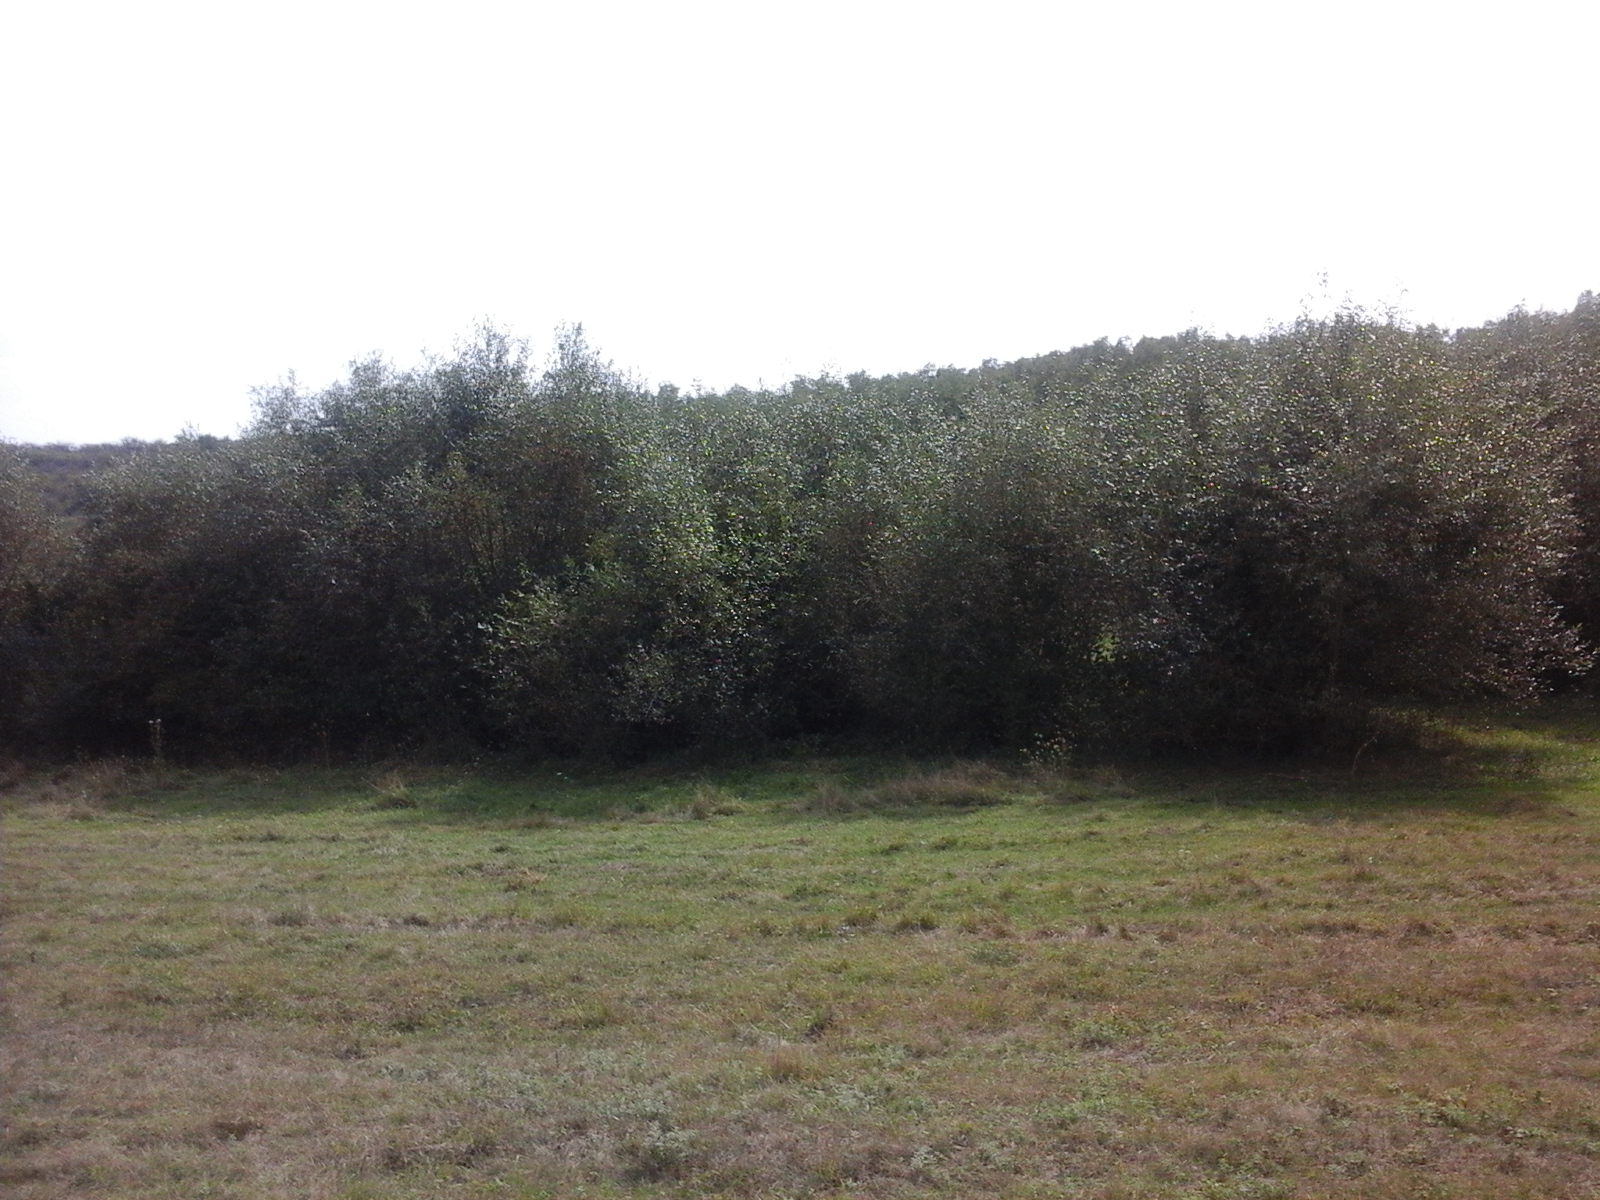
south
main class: Grassland
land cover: Grassland without tree/shrub cover
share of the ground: > 75 %
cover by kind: herbaceous plants 100 %
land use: Agriculture (excluding fallow land and kitchen gardens)
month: September
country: RO
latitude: 46.9144
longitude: 24.0645
